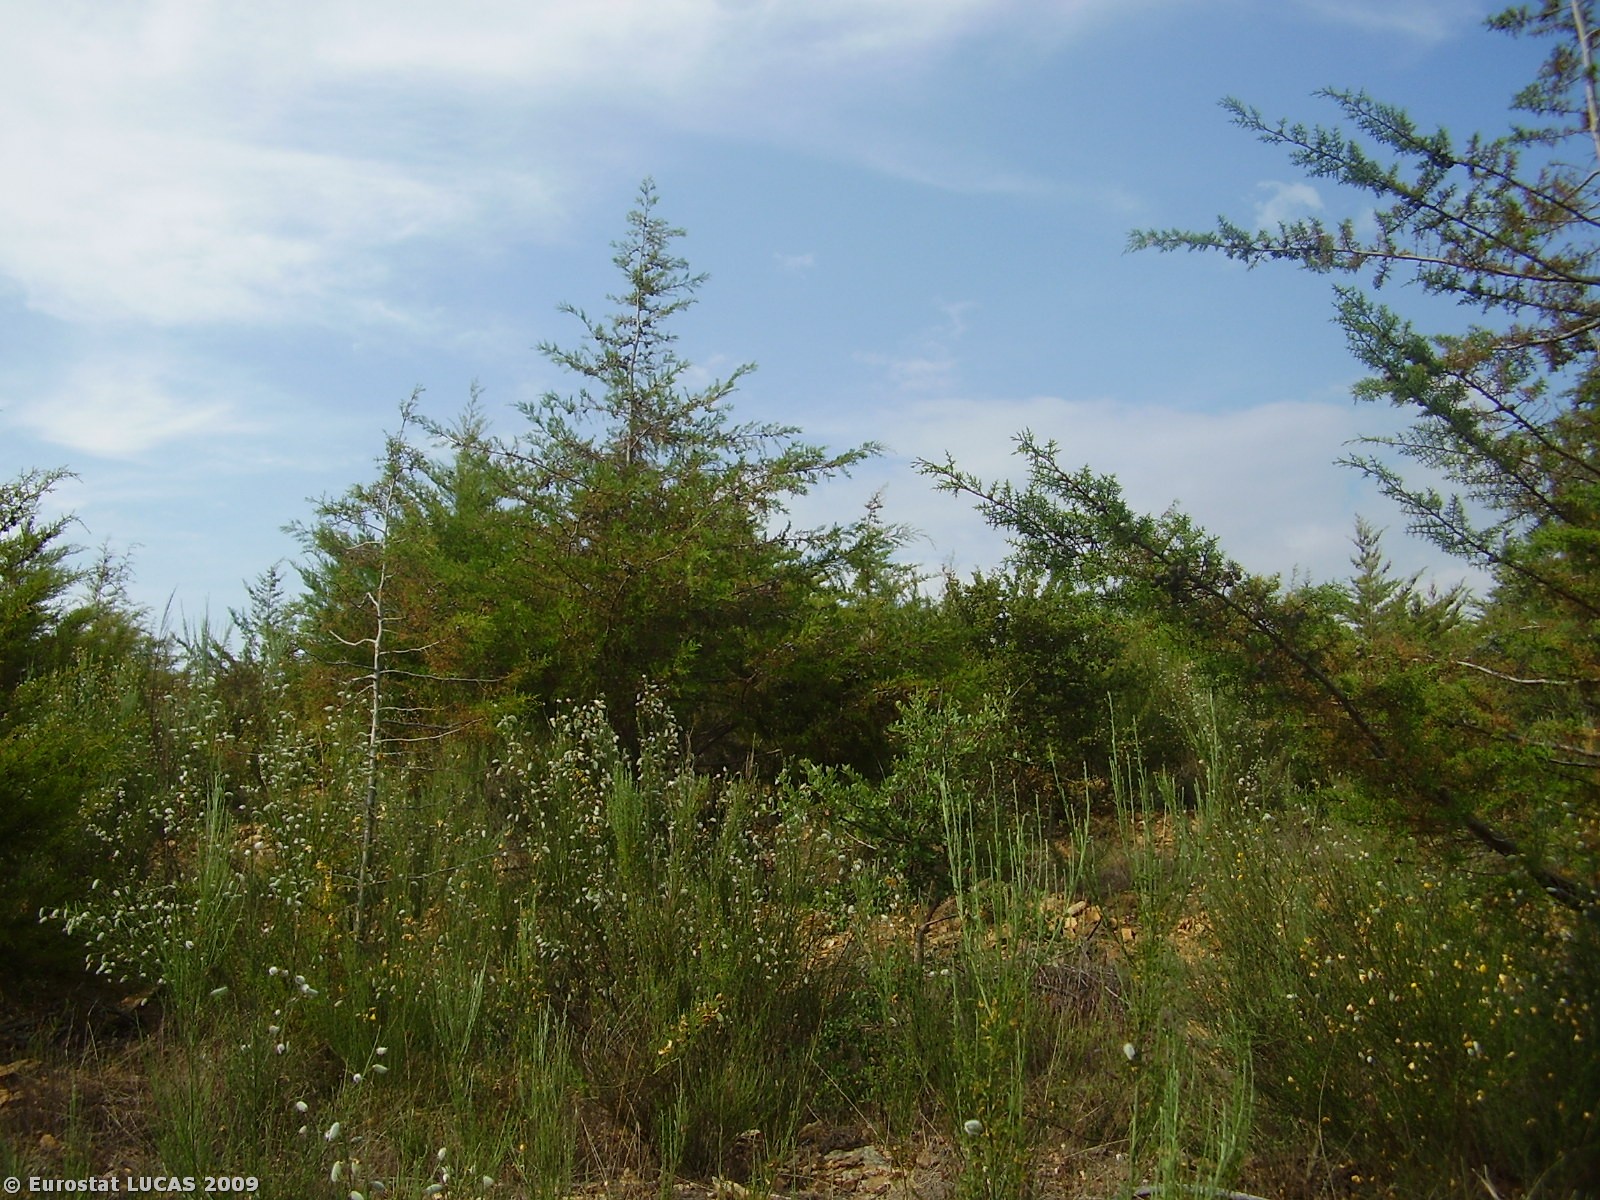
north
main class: Woodland
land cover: Coniferous woodland
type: coniferous forest of the mediterranean region
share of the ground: < 10 %
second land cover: Shrubland with sparse tree cover
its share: 50 - 75 %
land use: Forestry
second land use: Nature reserves
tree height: > 5 m
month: June
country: PT
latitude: 41.5947
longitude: -6.8726
